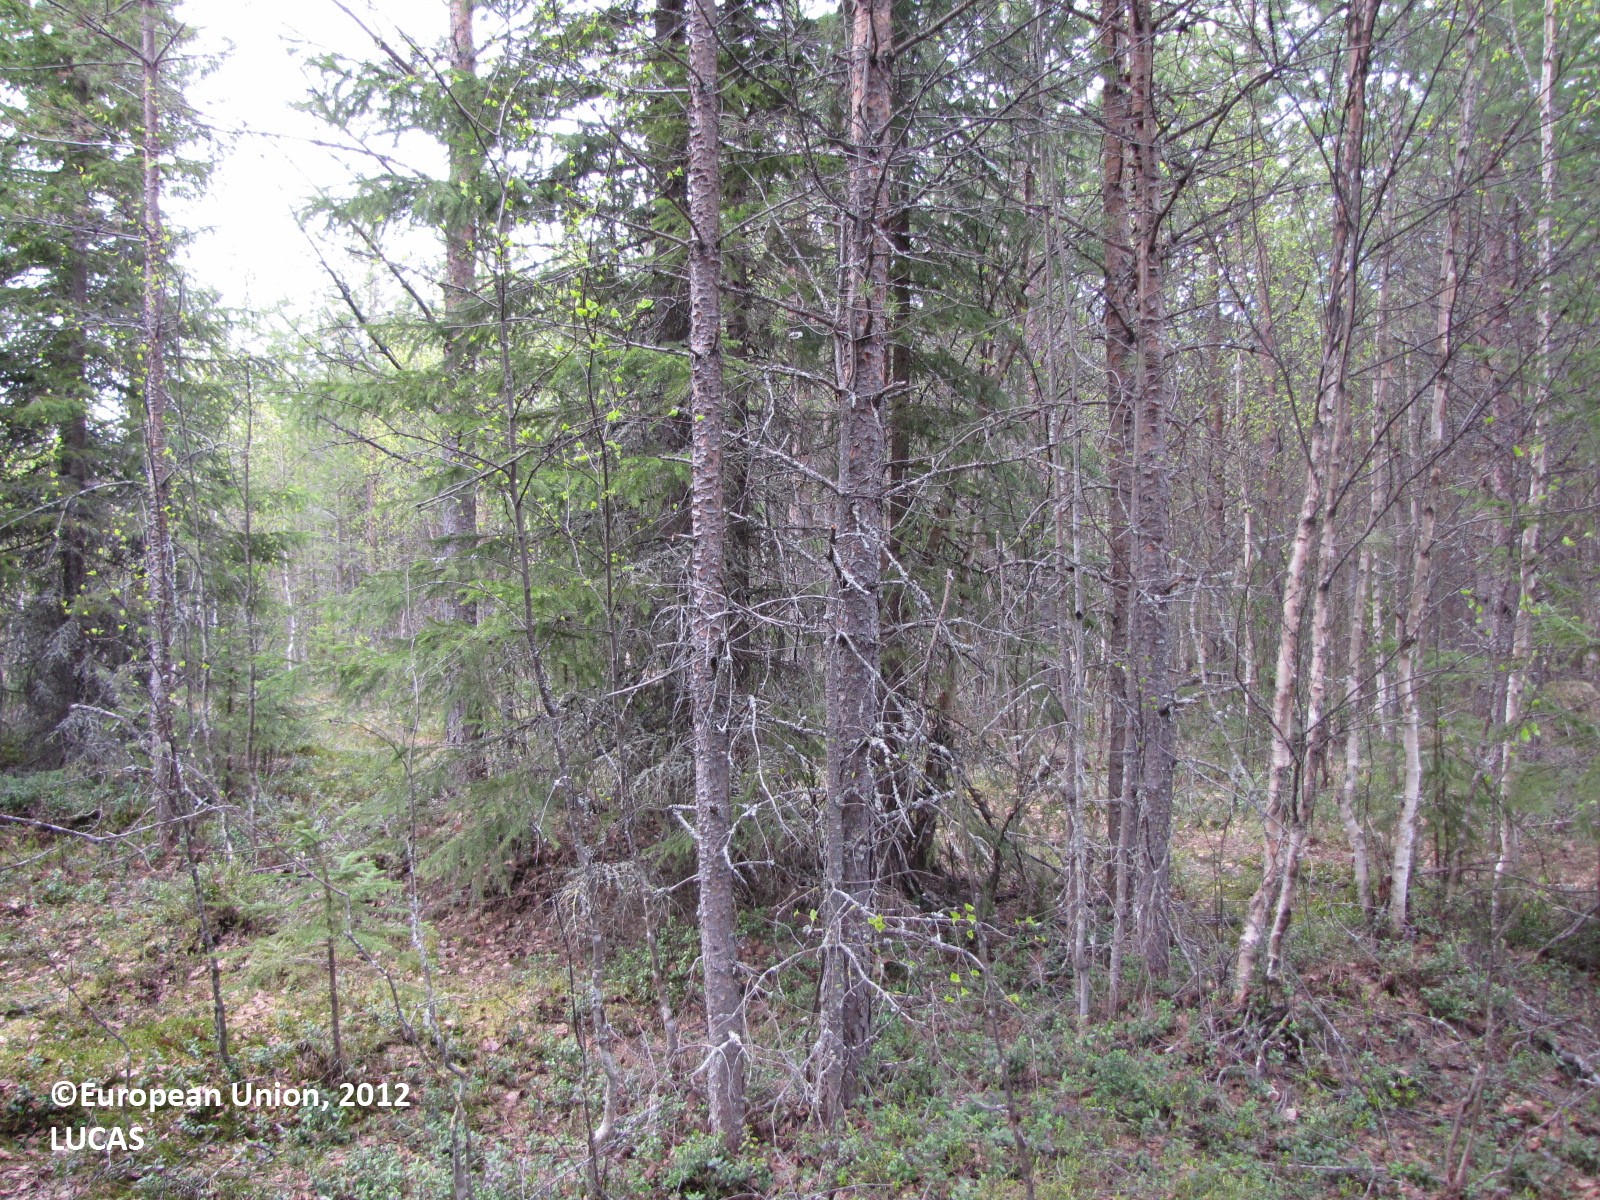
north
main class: Woodland
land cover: Other mixed woodland
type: boreal forest
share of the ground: > 75 %
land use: Forestry
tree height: > 5 m
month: May
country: FI
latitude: 65.7218
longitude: 24.6833
